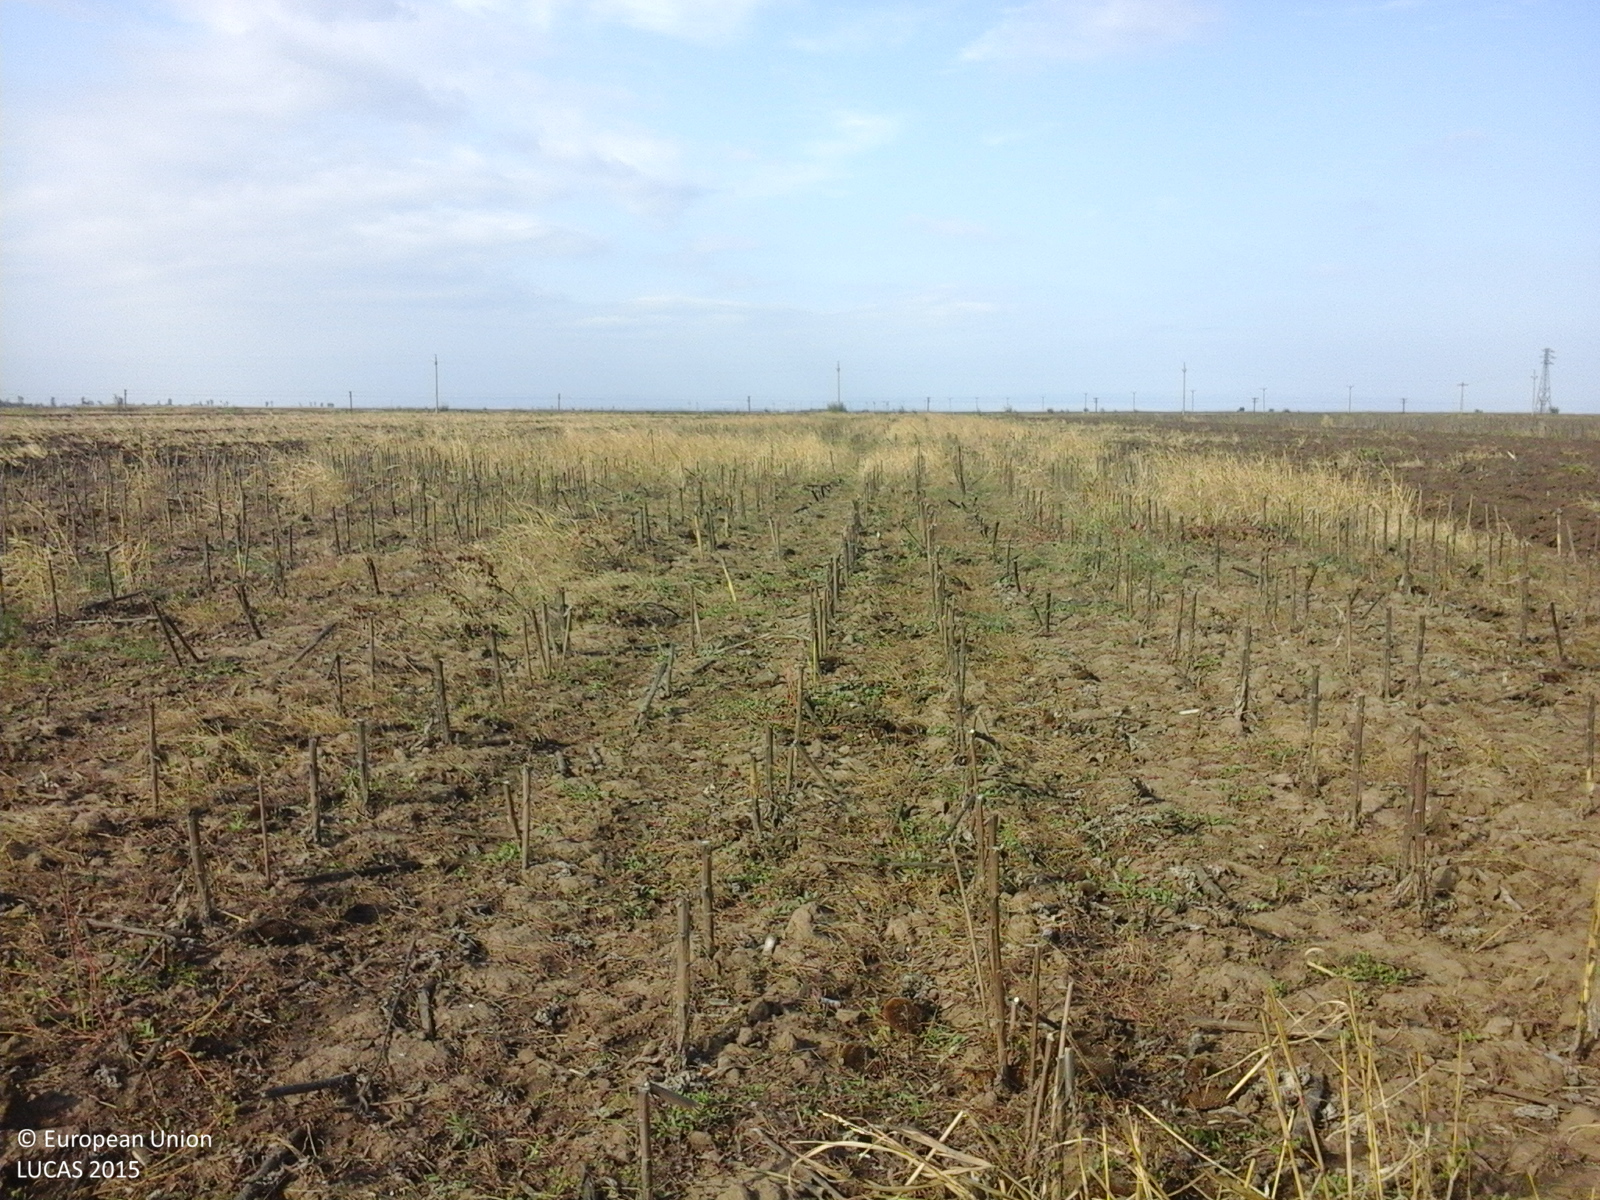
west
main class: Cropland
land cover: Sunflower
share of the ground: 10 - 25 %
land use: Agriculture (excluding fallow land and kitchen gardens)
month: October
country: RO
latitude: 45.1957
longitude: 27.2382
